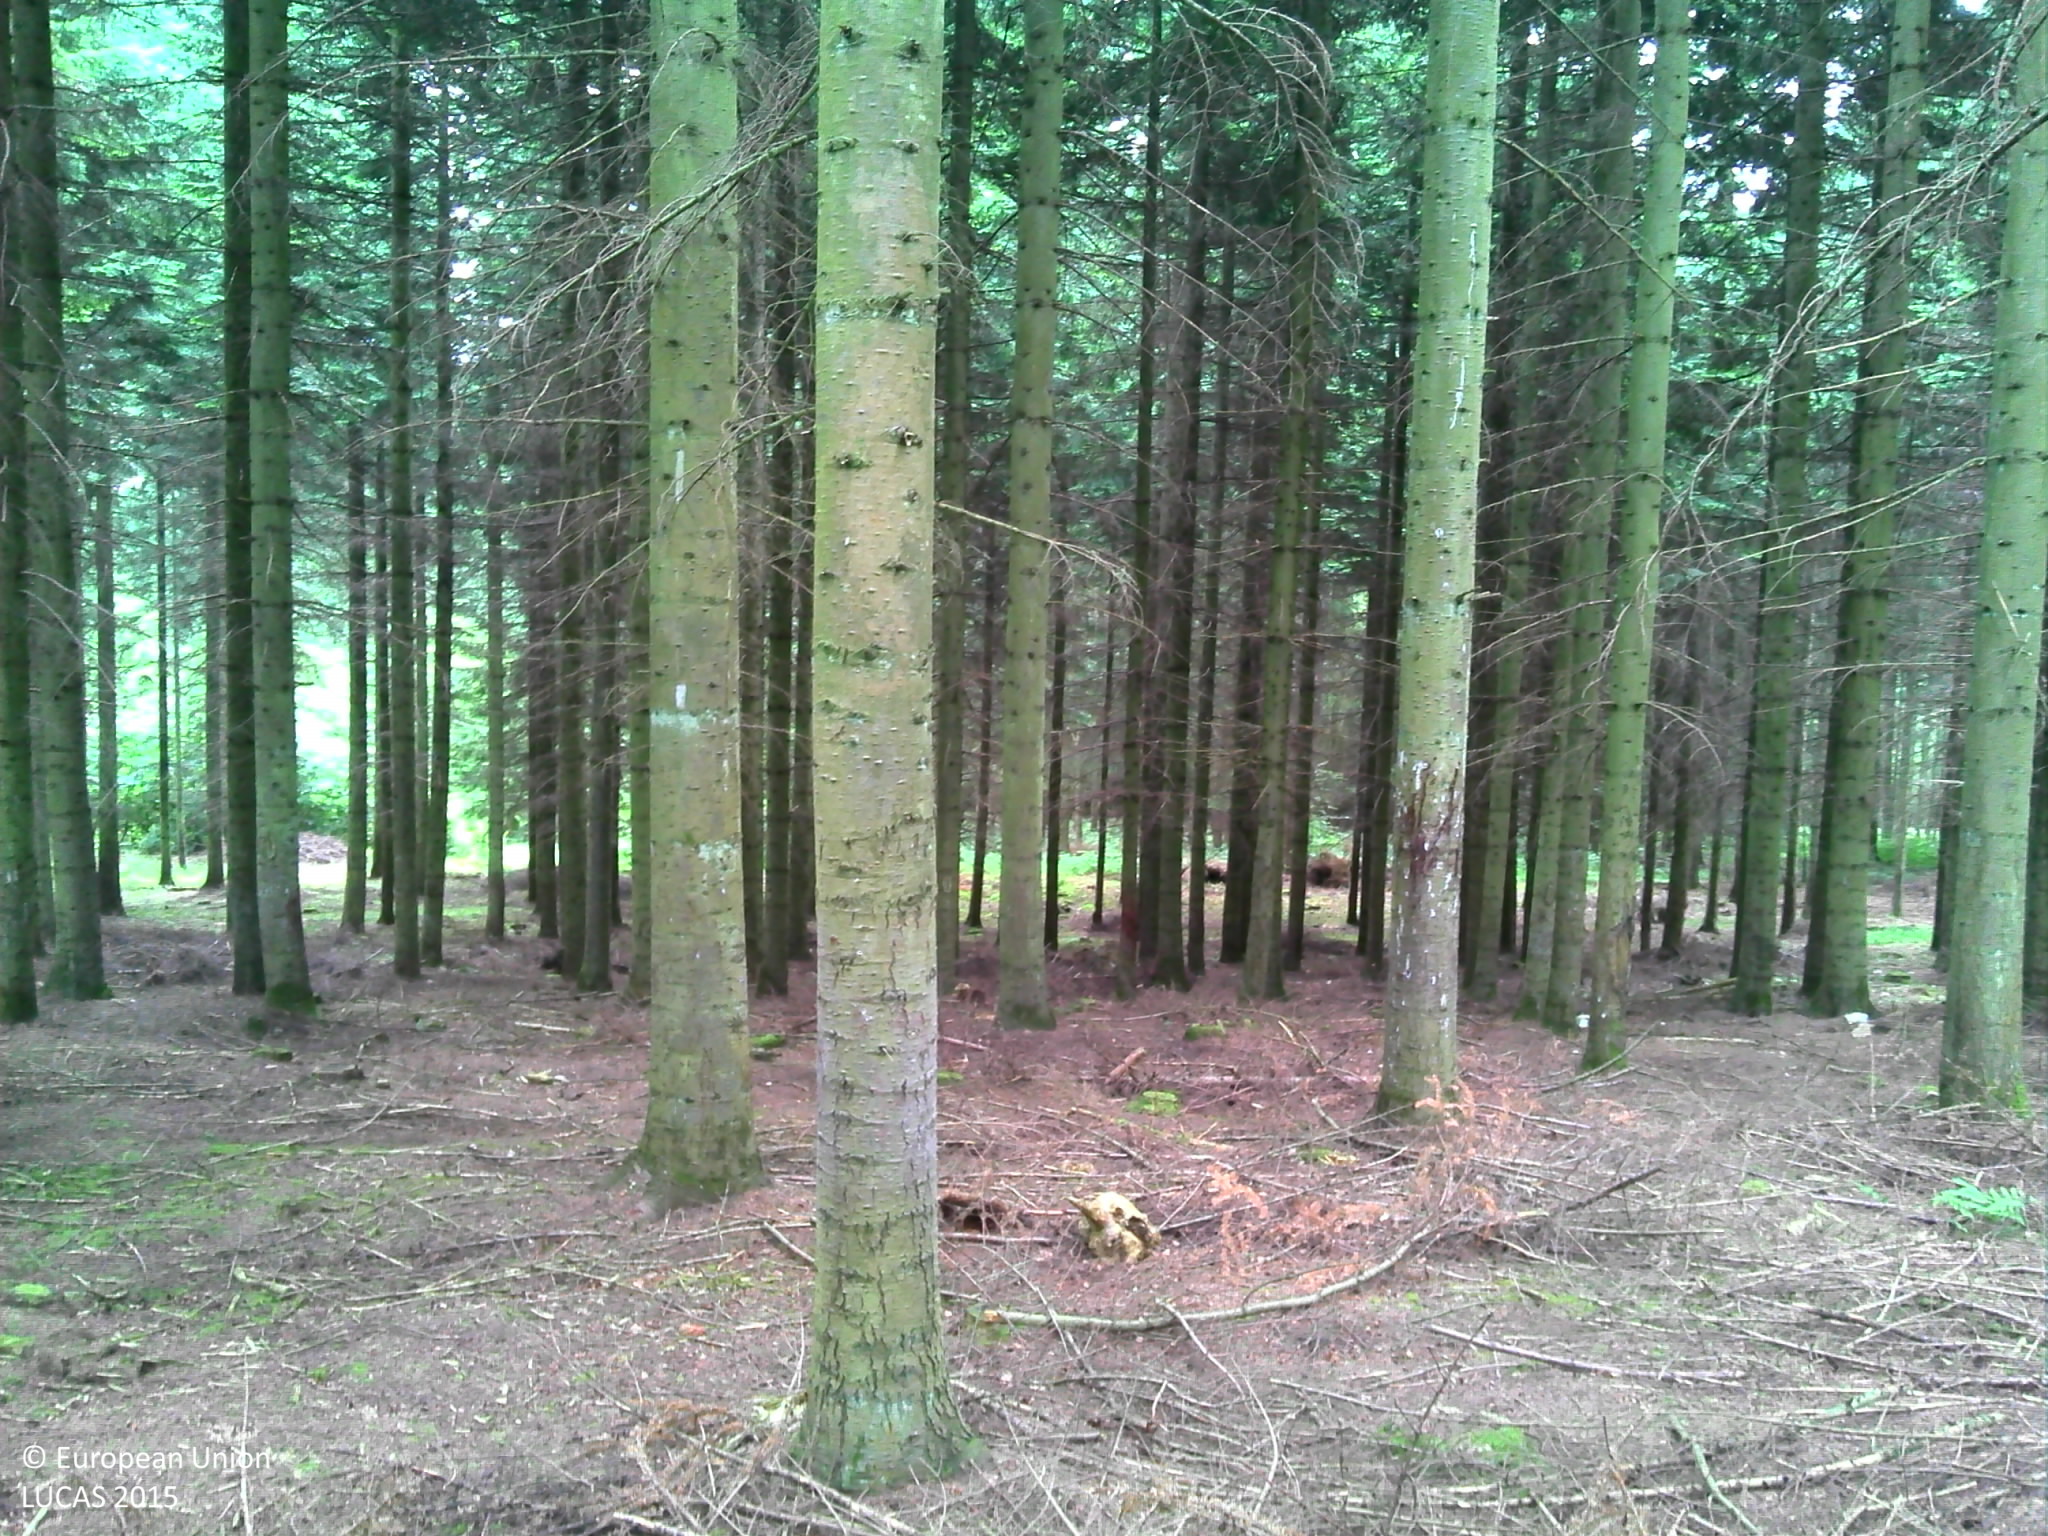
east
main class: Woodland
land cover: Other coniferous woodland
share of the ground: > 75 %
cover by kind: coniferous forest trees 80 %, unconsolidated bare surface 20 %
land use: Forestry
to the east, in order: Other coniferous woodland; Tracks; Spruce dominated coniferous woodland; Broadleaved woodland; Spruce dominated coniferous woodland; Rivers and streams; Tracks; Spruce dominated coniferous woodland
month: July
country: BE
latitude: 50.3081
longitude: 5.8848
